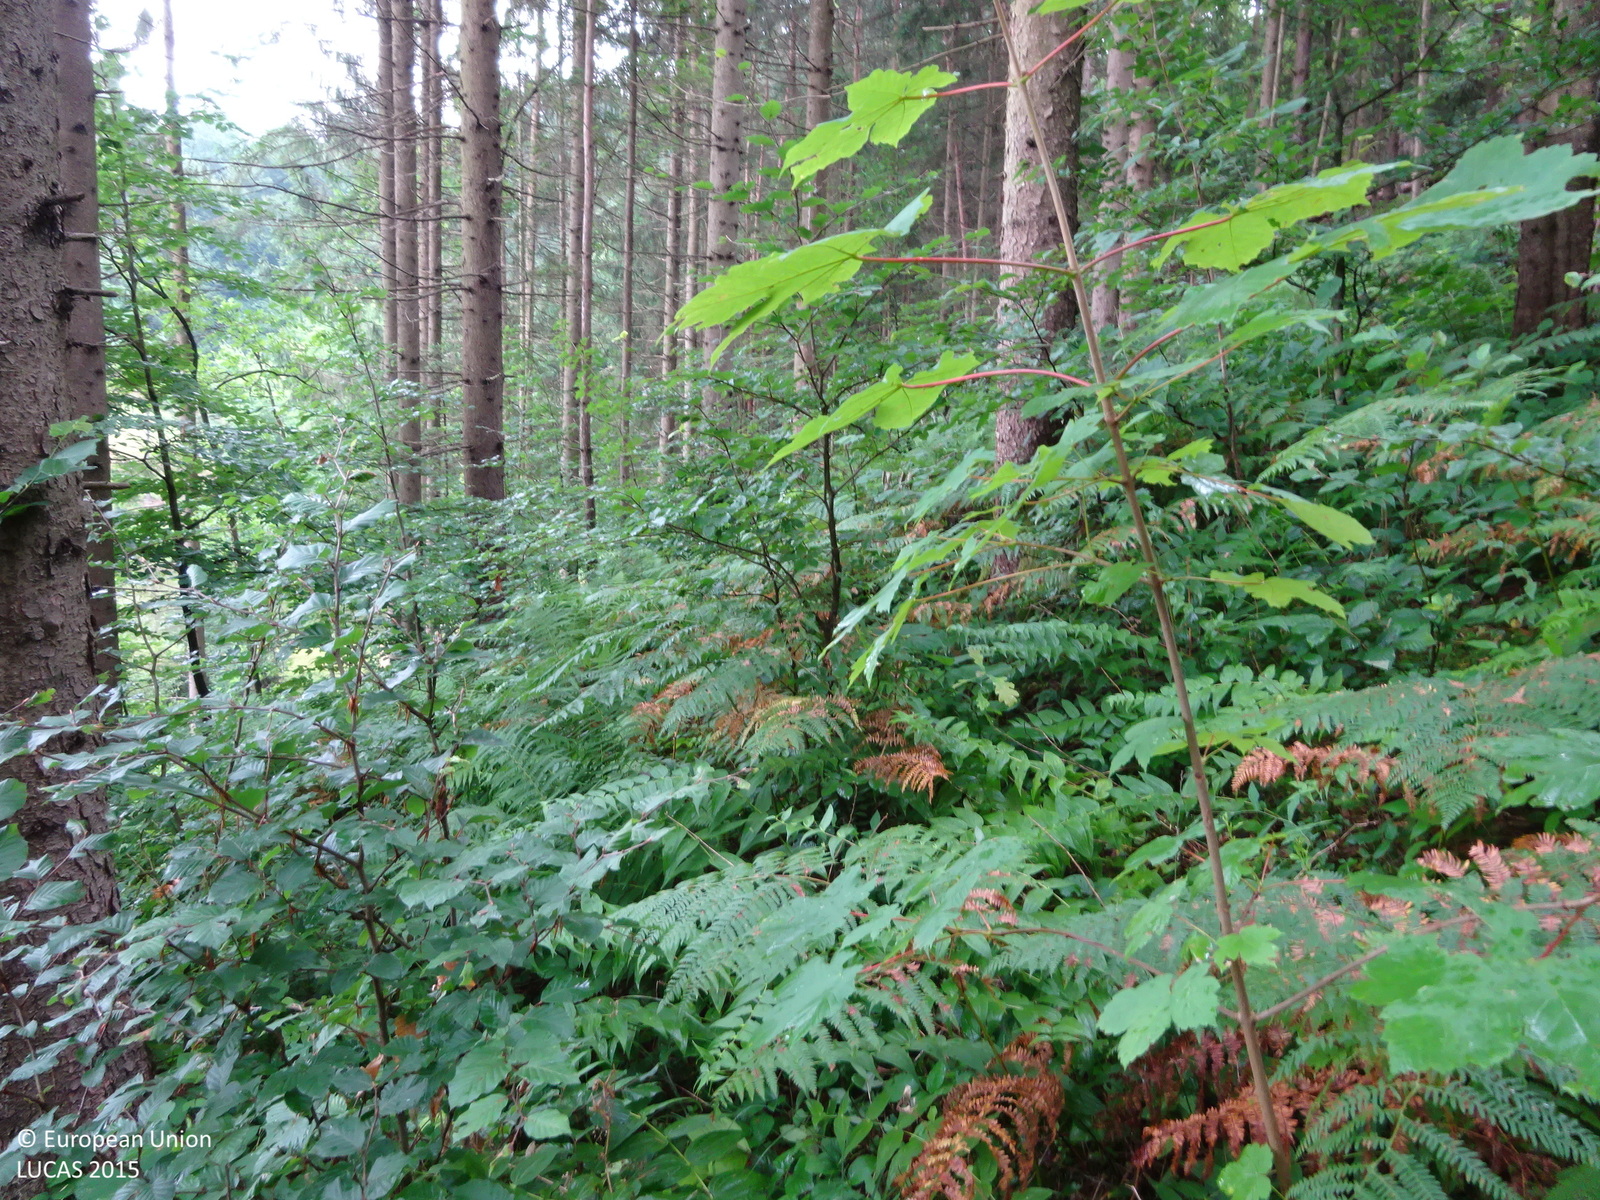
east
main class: Woodland
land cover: Spruce dominated coniferous woodland
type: alpine coniferous forest
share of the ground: > 75 %
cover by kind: coniferous forest trees 90 %, shrubs 5 %, herbaceous plants 5 %
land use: Forestry
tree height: > 5 m
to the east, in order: Spruce dominated coniferous woodland; Grassland without tree/shrub cover; Inland fresh water bodies; Grassland without tree/shrub cover; Spruce dominated mixed woodland; Broadleaved woodland
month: July
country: AT
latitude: 46.7932
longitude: 15.3835
